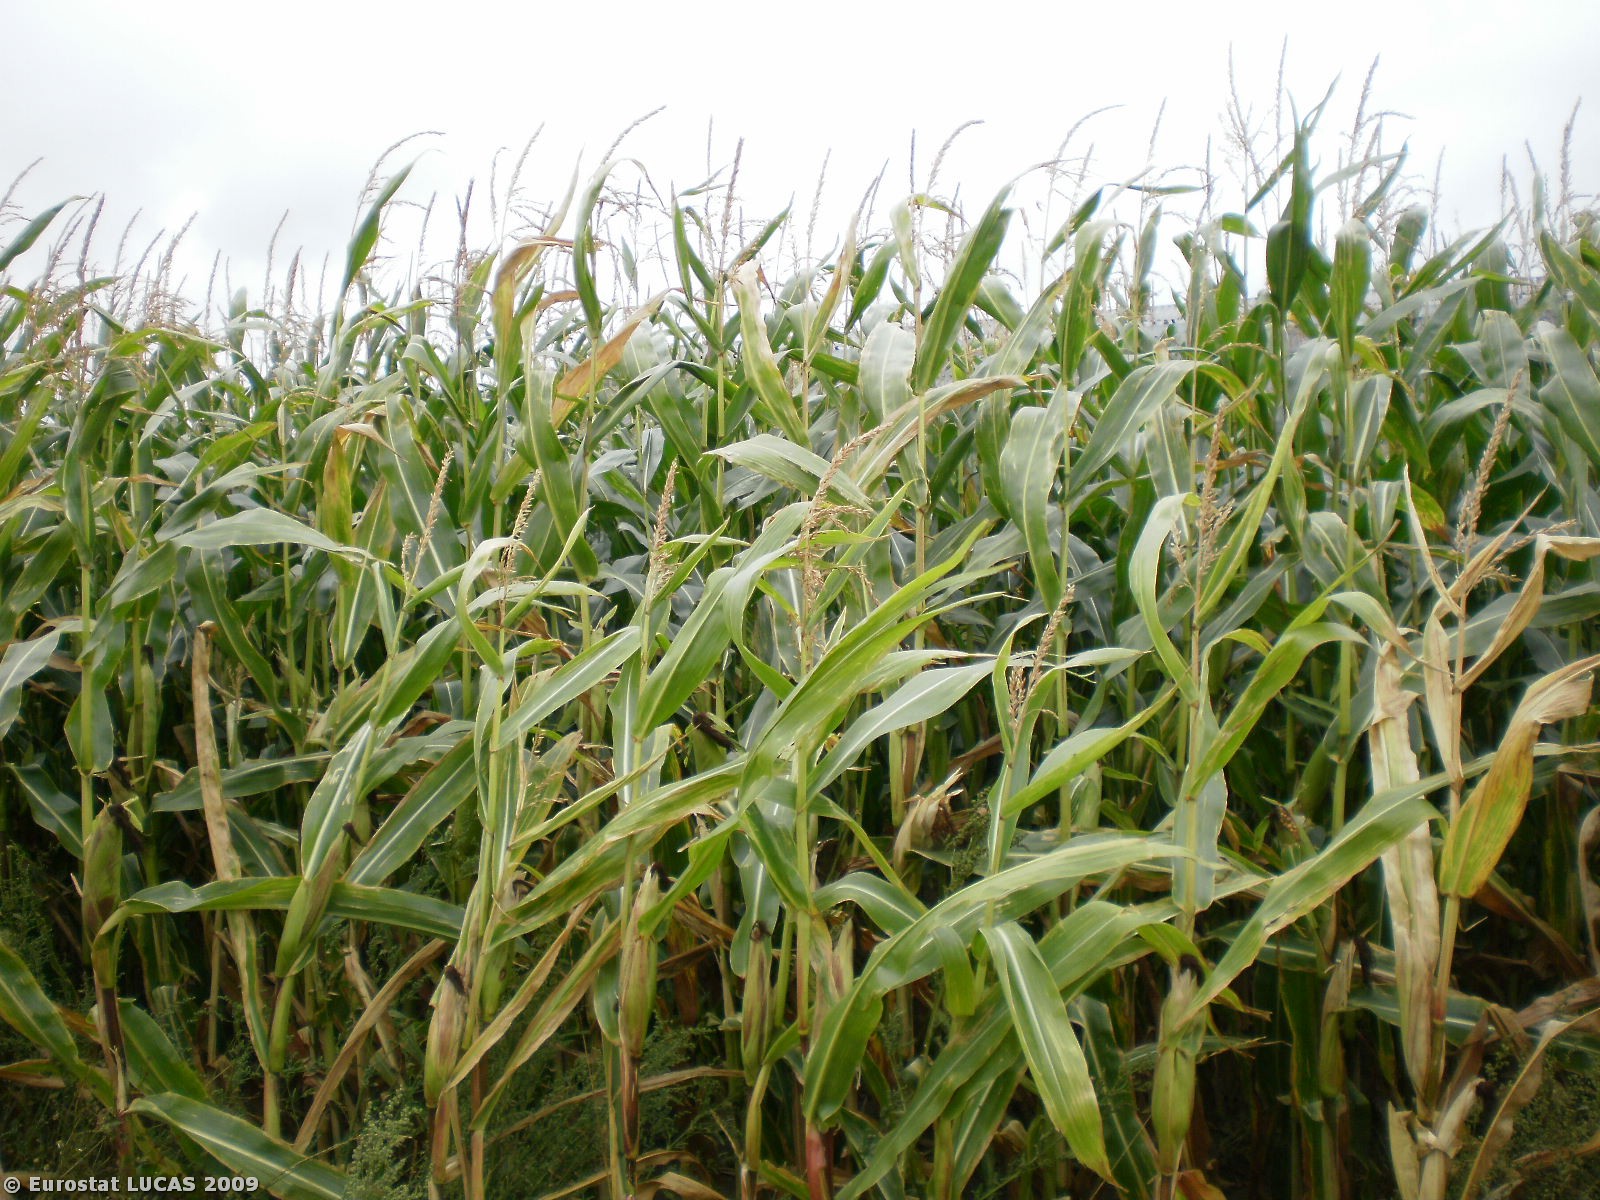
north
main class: Cropland
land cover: Maize
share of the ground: > 75 %
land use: Agriculture (excluding fallow land and kitchen gardens)
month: September
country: PL
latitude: 53.8756
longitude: 17.7548
